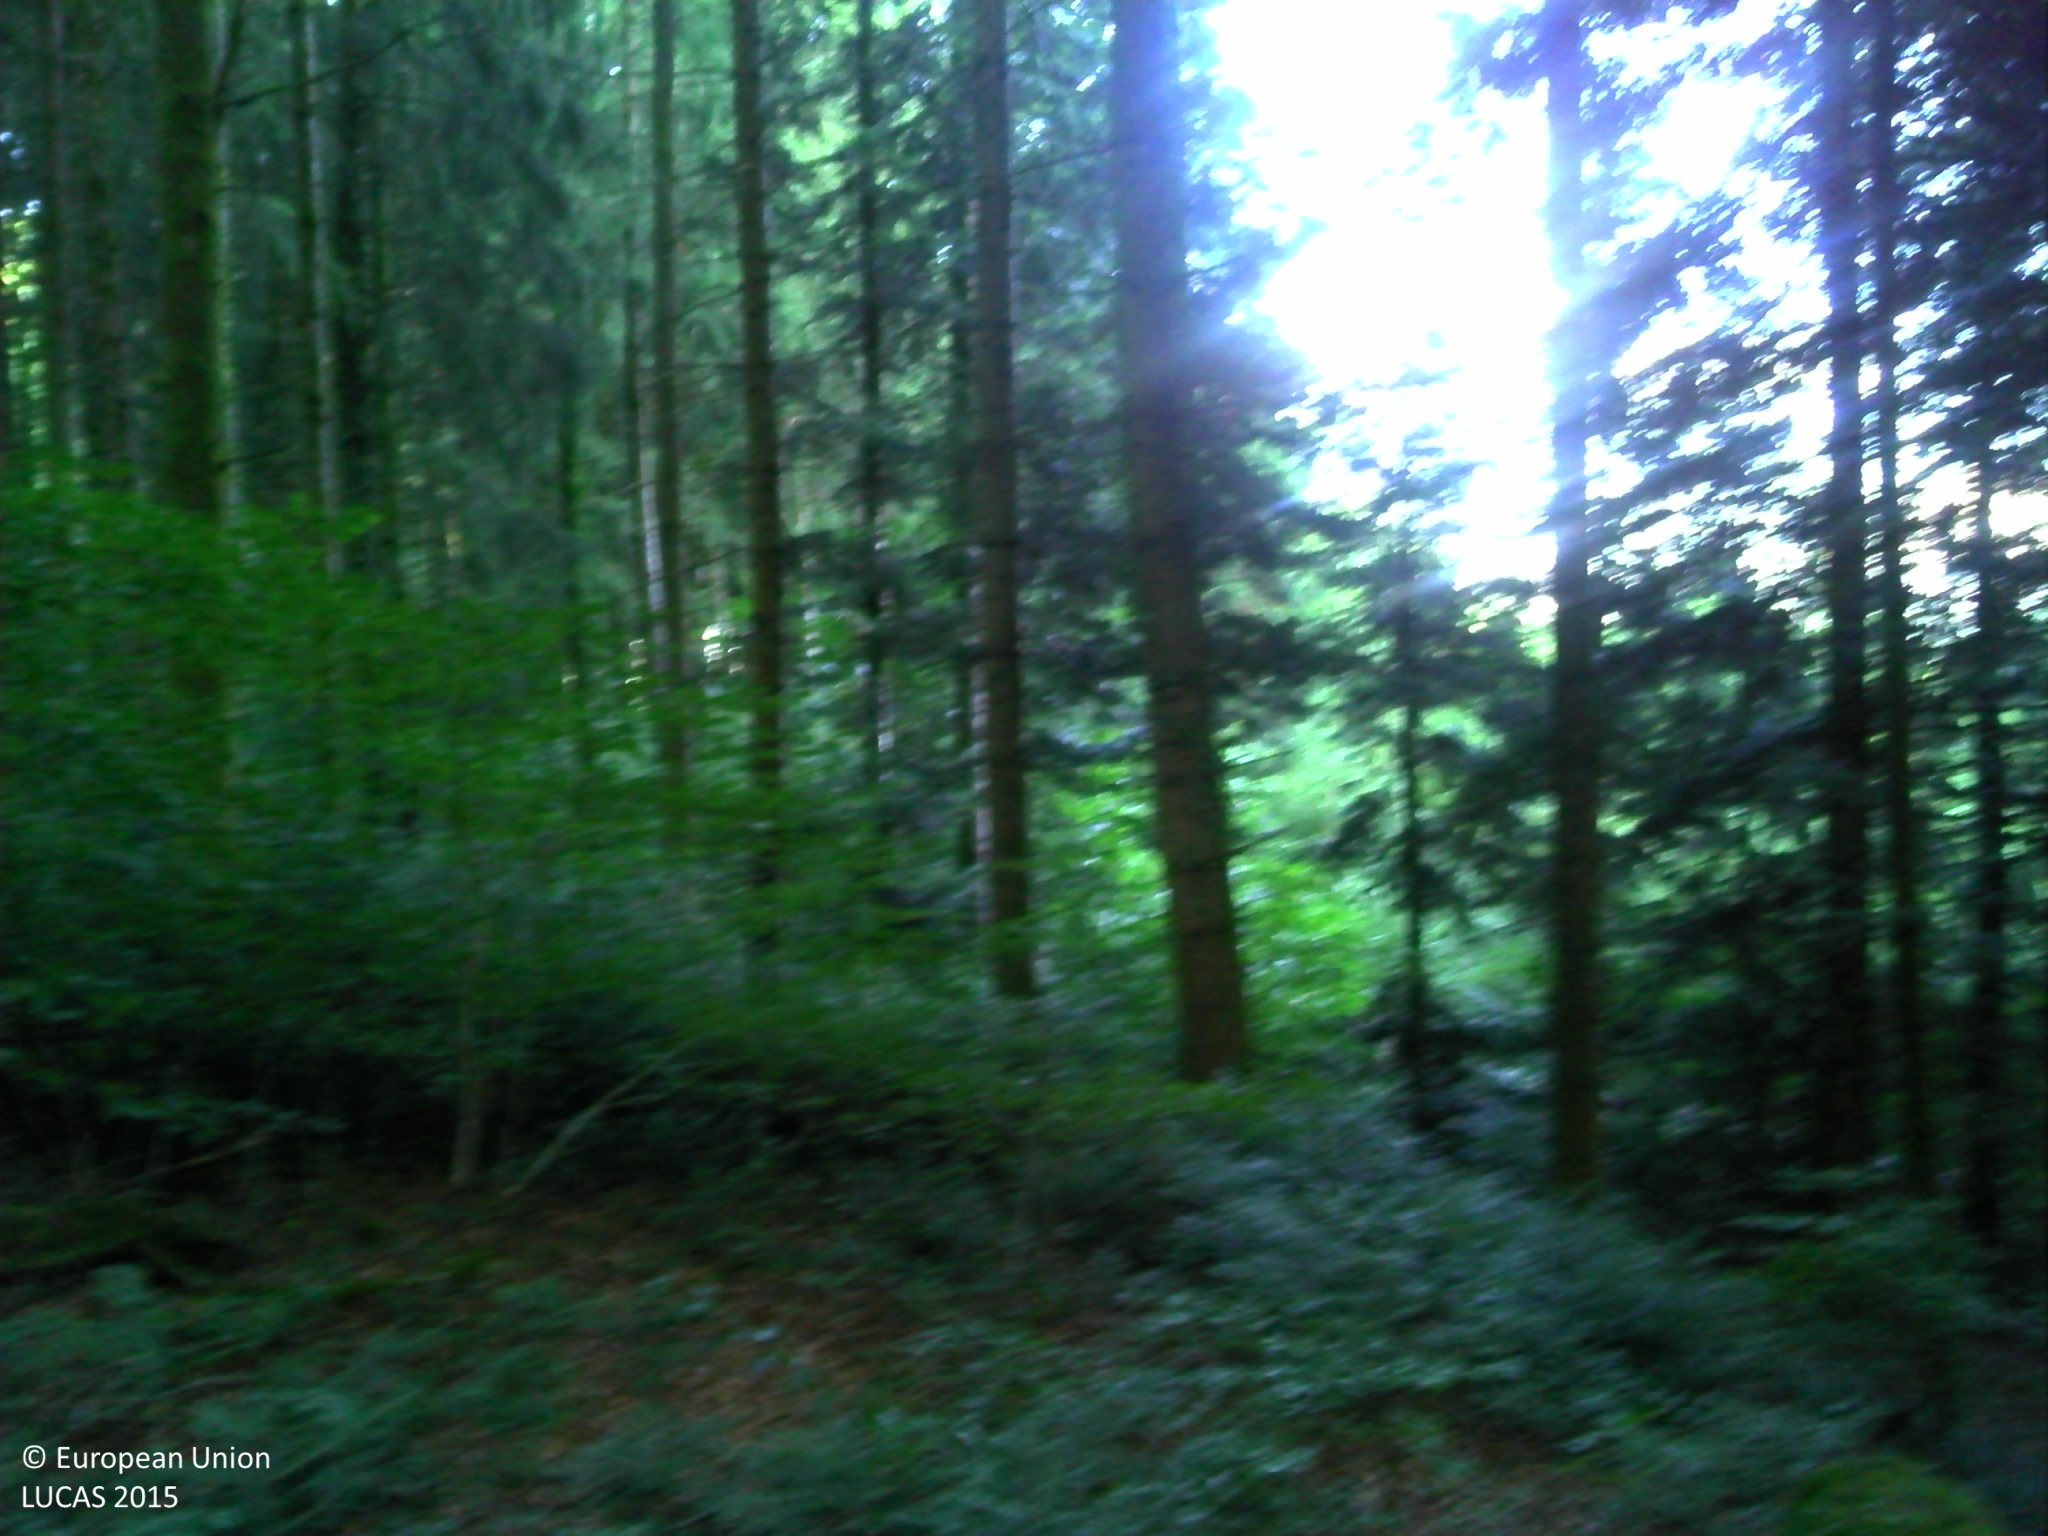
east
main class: Woodland
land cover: Other mixed woodland
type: exotic forest
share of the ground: > 75 %
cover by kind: coniferous forest trees 60 %, broadleaved forest trees 25 %, shrubs 5 %, herbaceous plants 5 %, lichens and mosses 5 %
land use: Forestry
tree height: > 5 m
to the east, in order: Other mixed woodland; Other coniferous woodland; Broadleaved woodland; Ditches and canals; Grass margins; Paved roads, cycling and walking lanes; Grass margins; Other coniferous woodland; Broadleaved woodland; Shrubland without tree cover
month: August
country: FR
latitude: 45.8900
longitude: 1.7847
